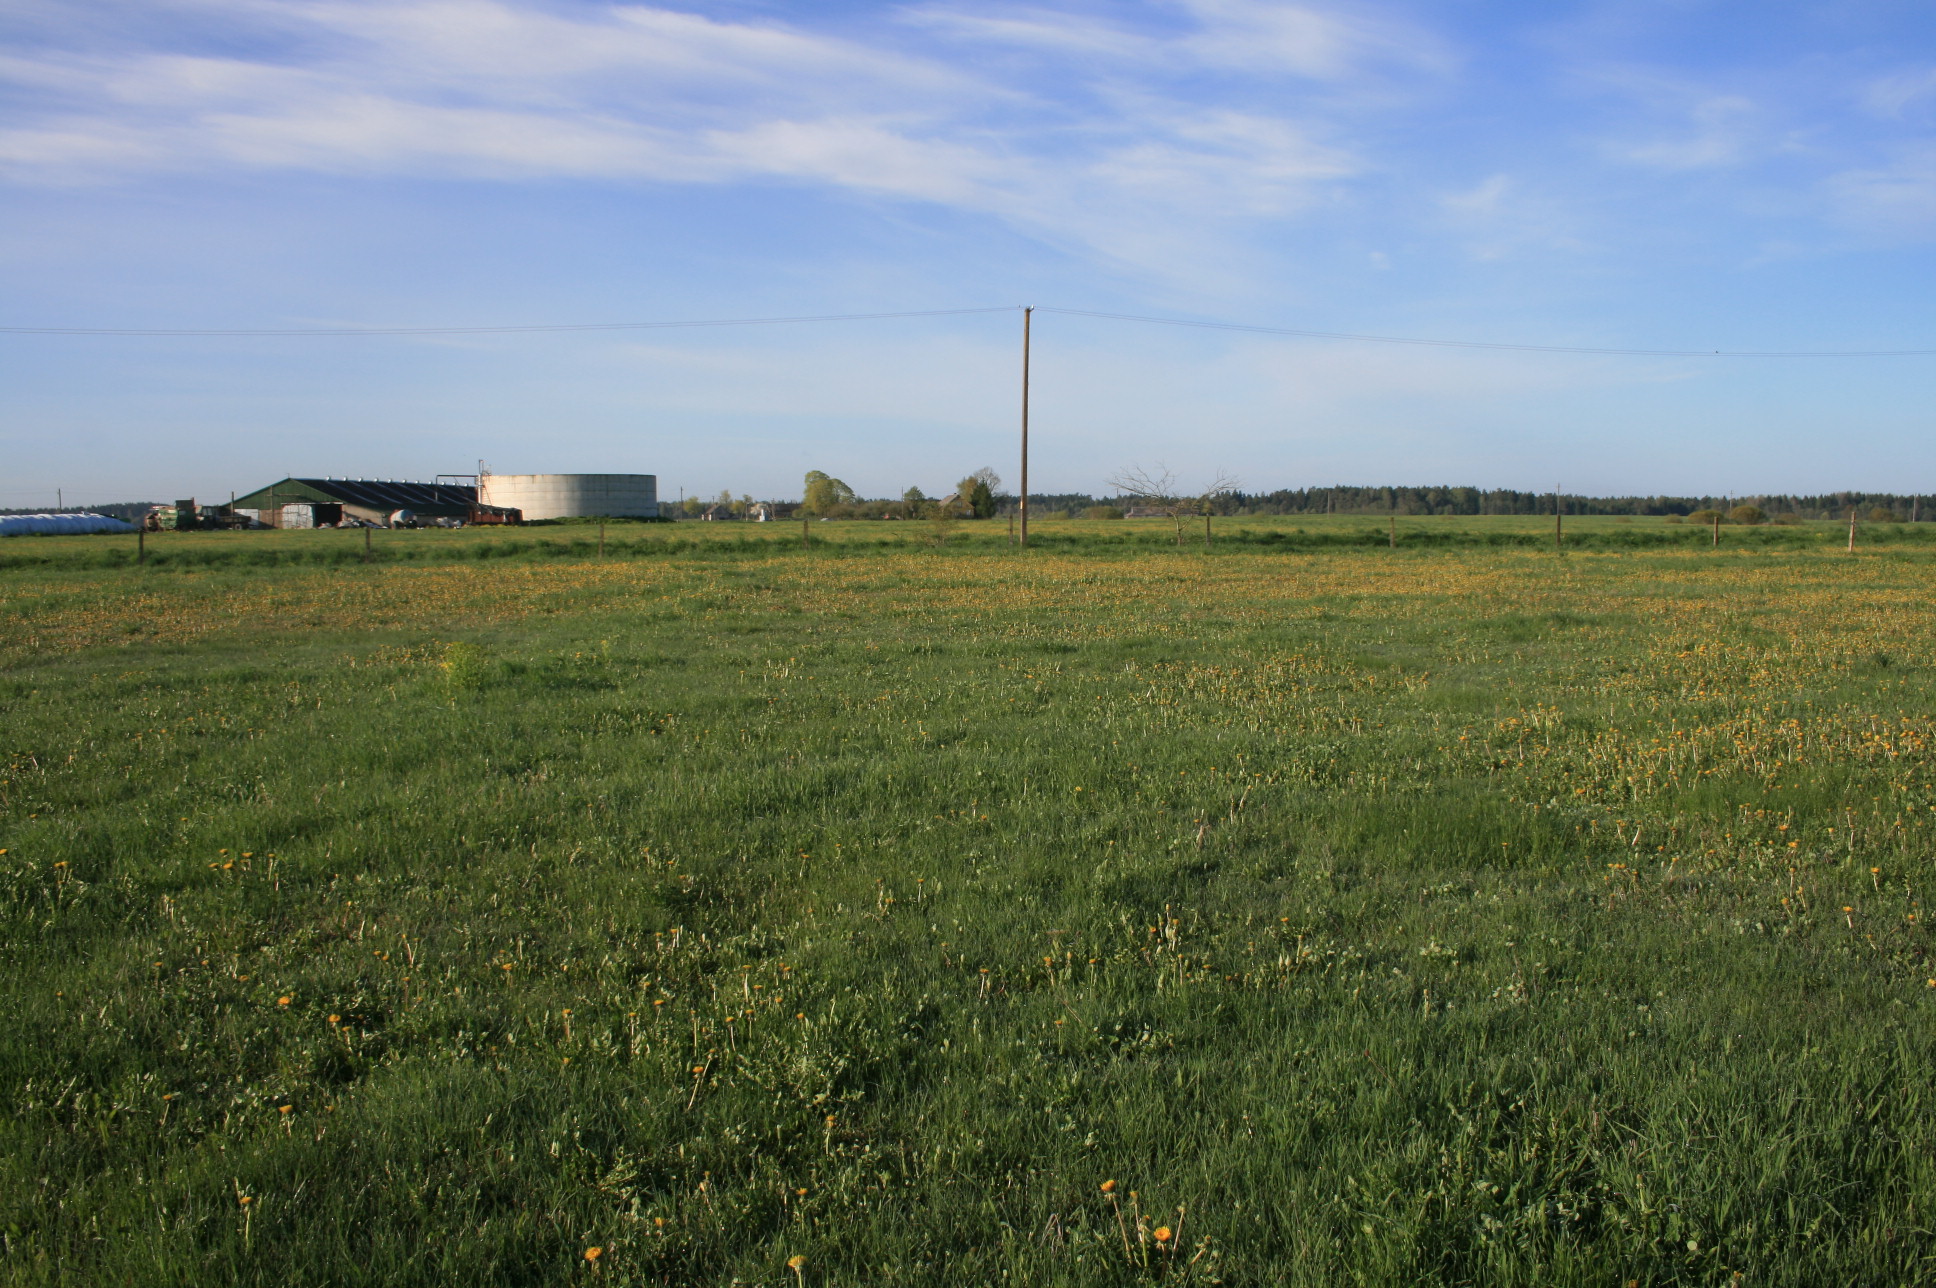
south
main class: Grassland
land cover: Grassland without tree/shrub cover
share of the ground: > 75 %
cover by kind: herbaceous plants 100 %
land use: Agriculture (excluding fallow land and kitchen gardens)
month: May
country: LT
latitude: 56.1399
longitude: 21.5181
